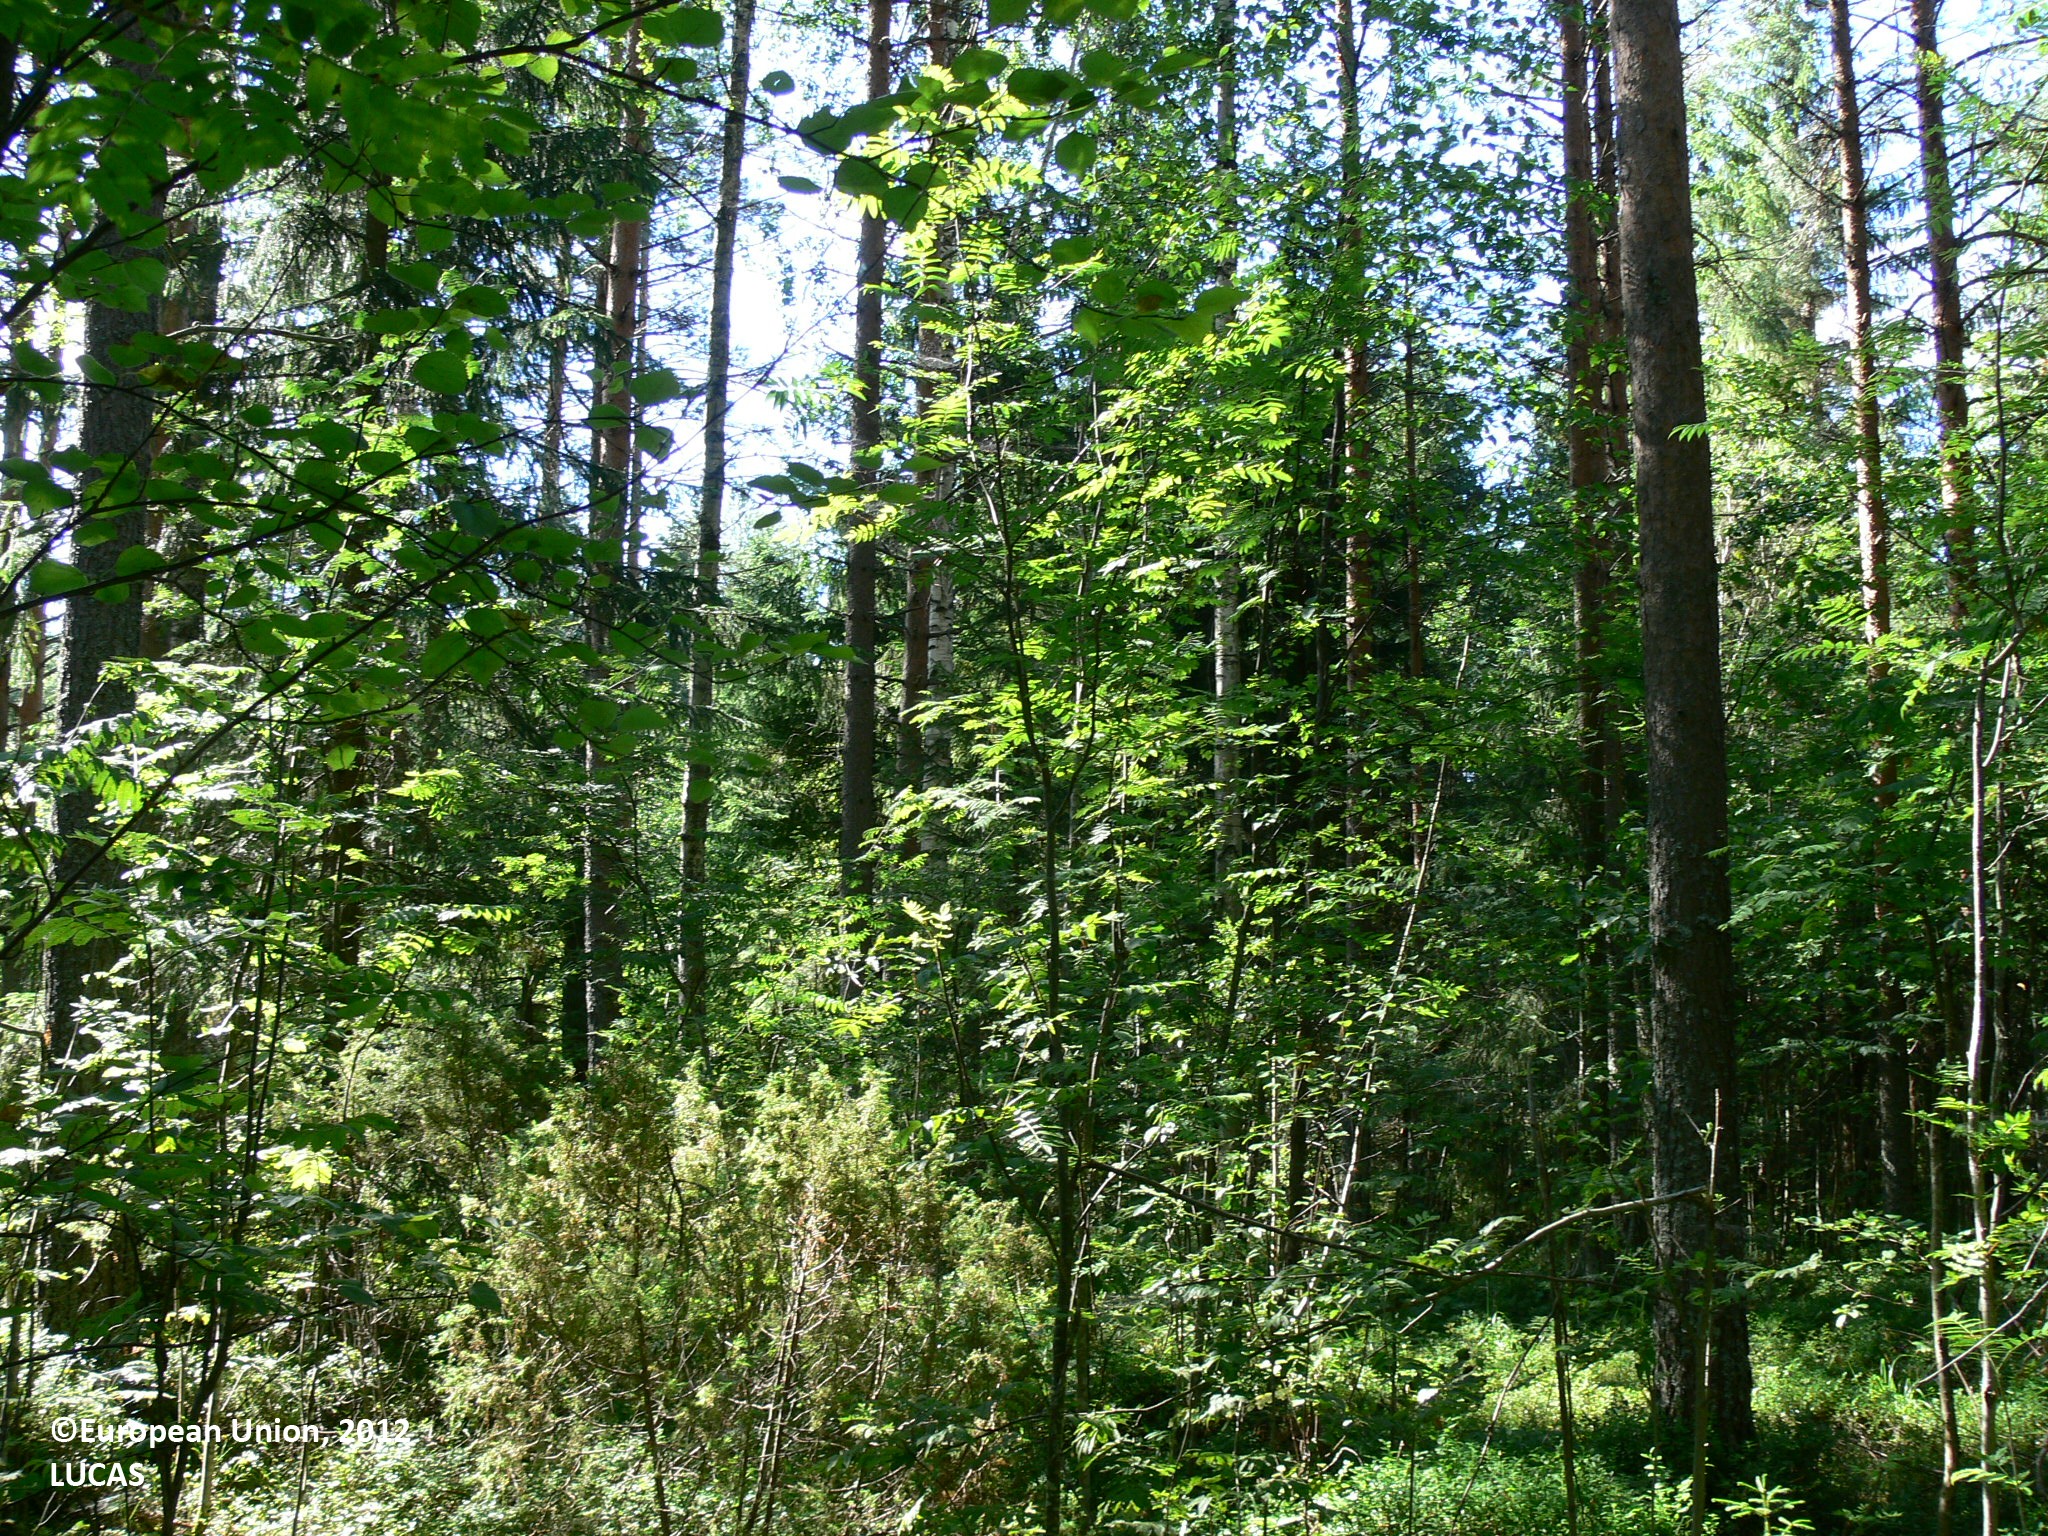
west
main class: Woodland
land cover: Pine dominated mixed woodland
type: boreal forest
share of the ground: > 75 %
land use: Forestry
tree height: > 5 m
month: July
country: FI
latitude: 63.3284
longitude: 29.4154
